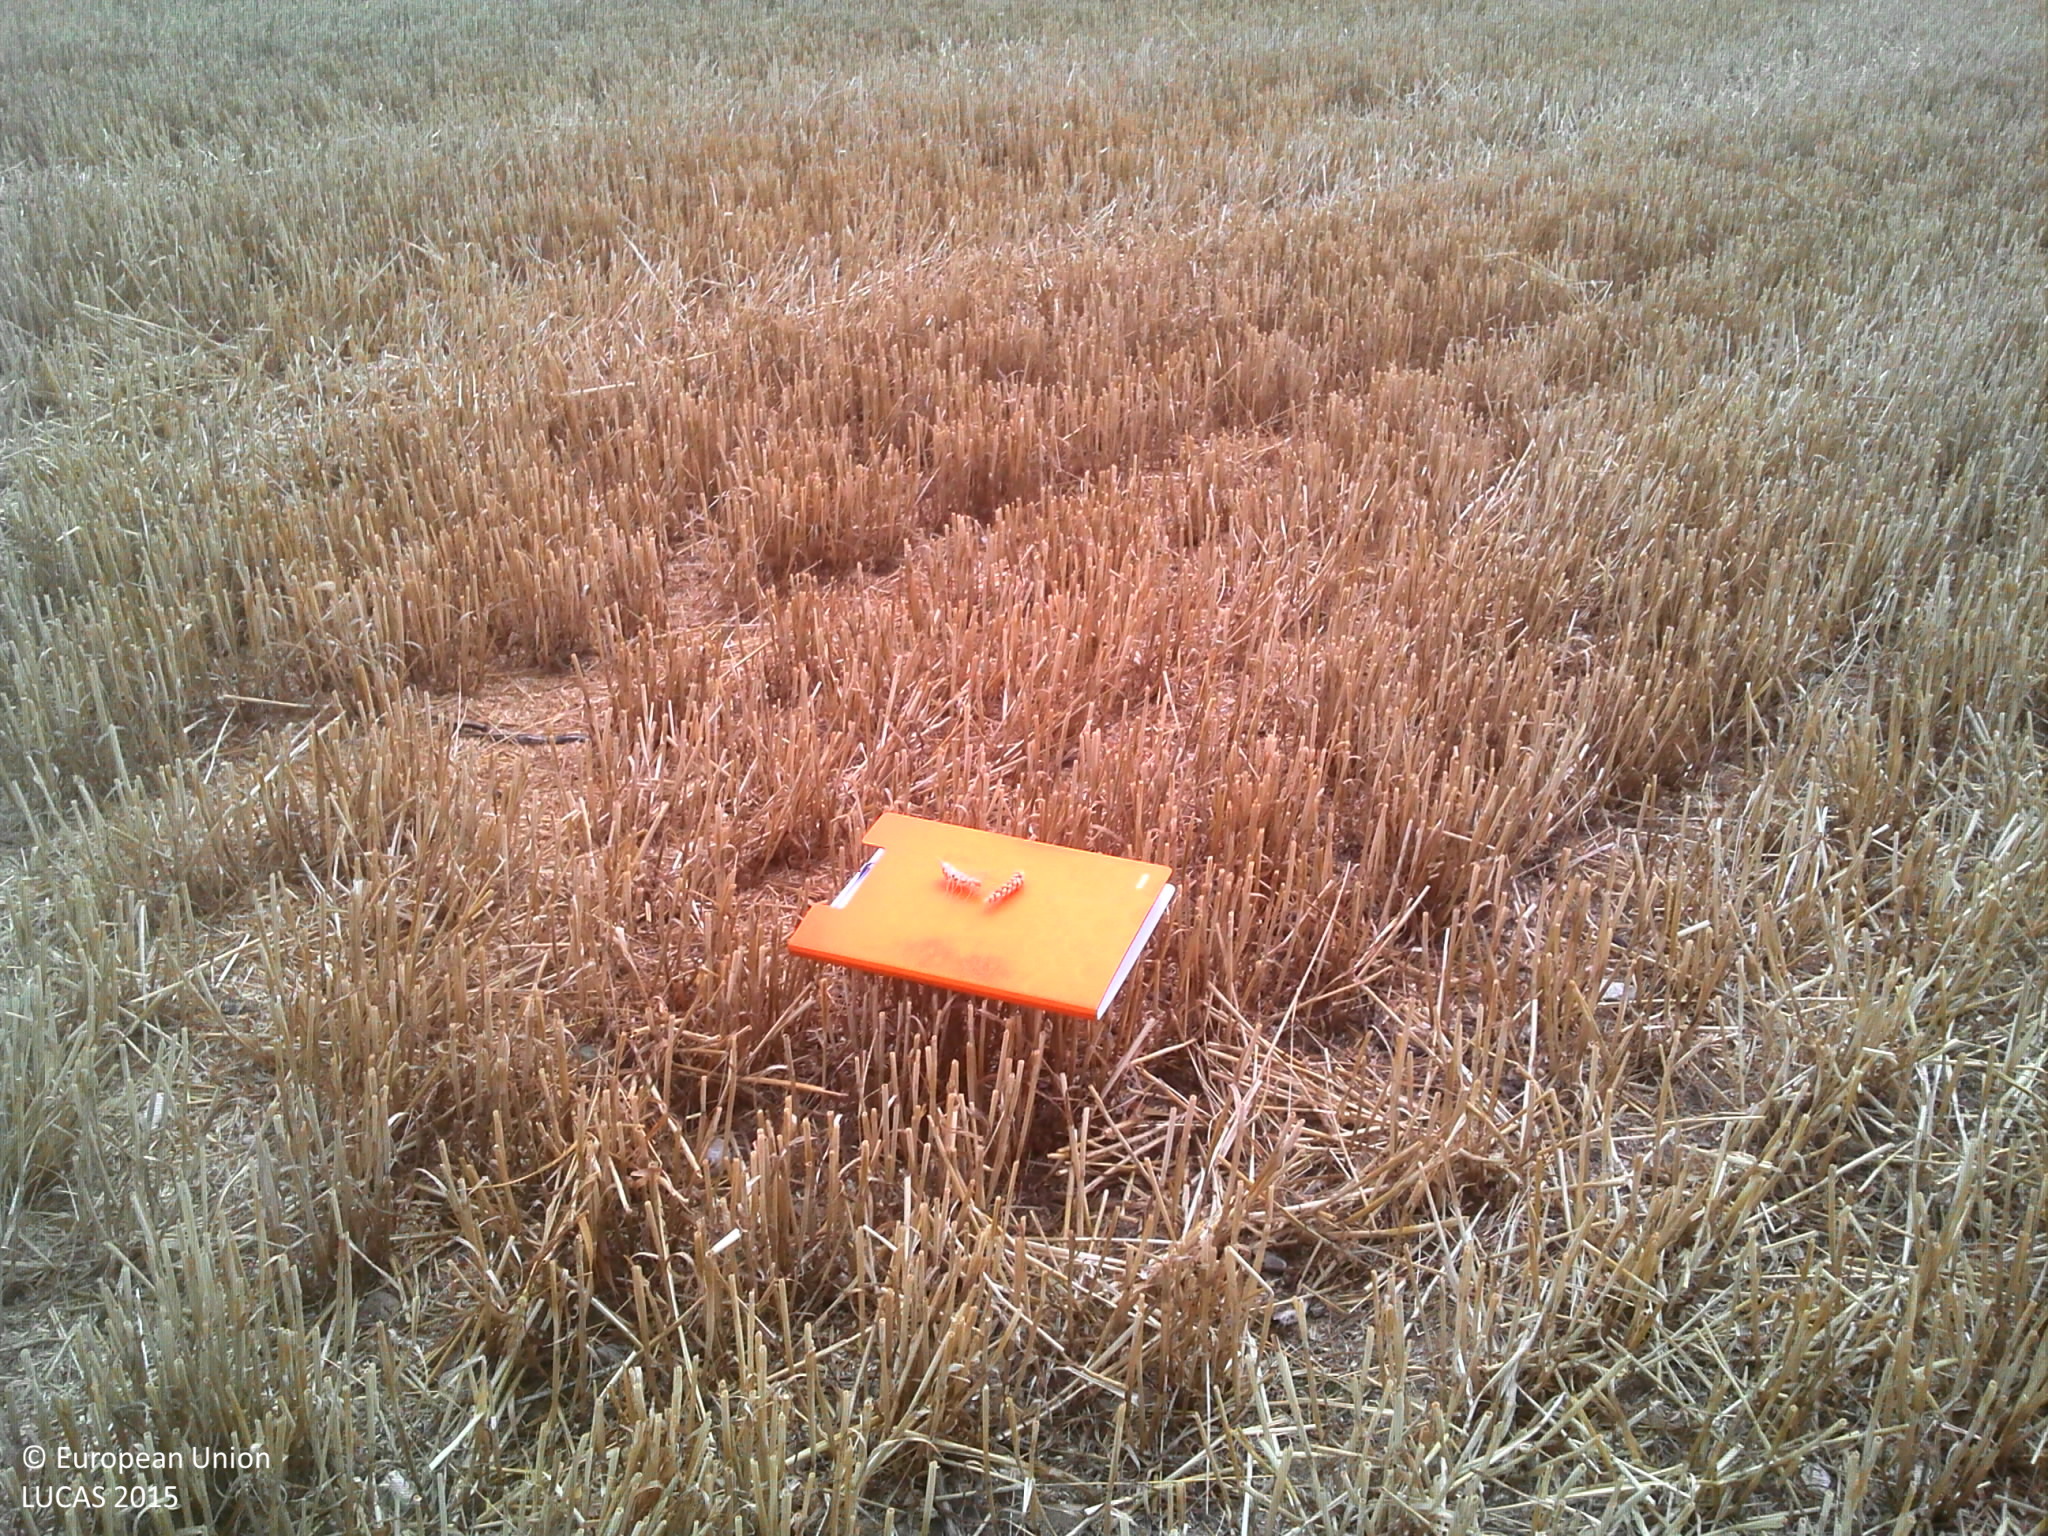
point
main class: Cropland
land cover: Common wheat
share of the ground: 10 - 25 %
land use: Agriculture (excluding fallow land and kitchen gardens)
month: July
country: FR
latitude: 47.9912
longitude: 5.1620
